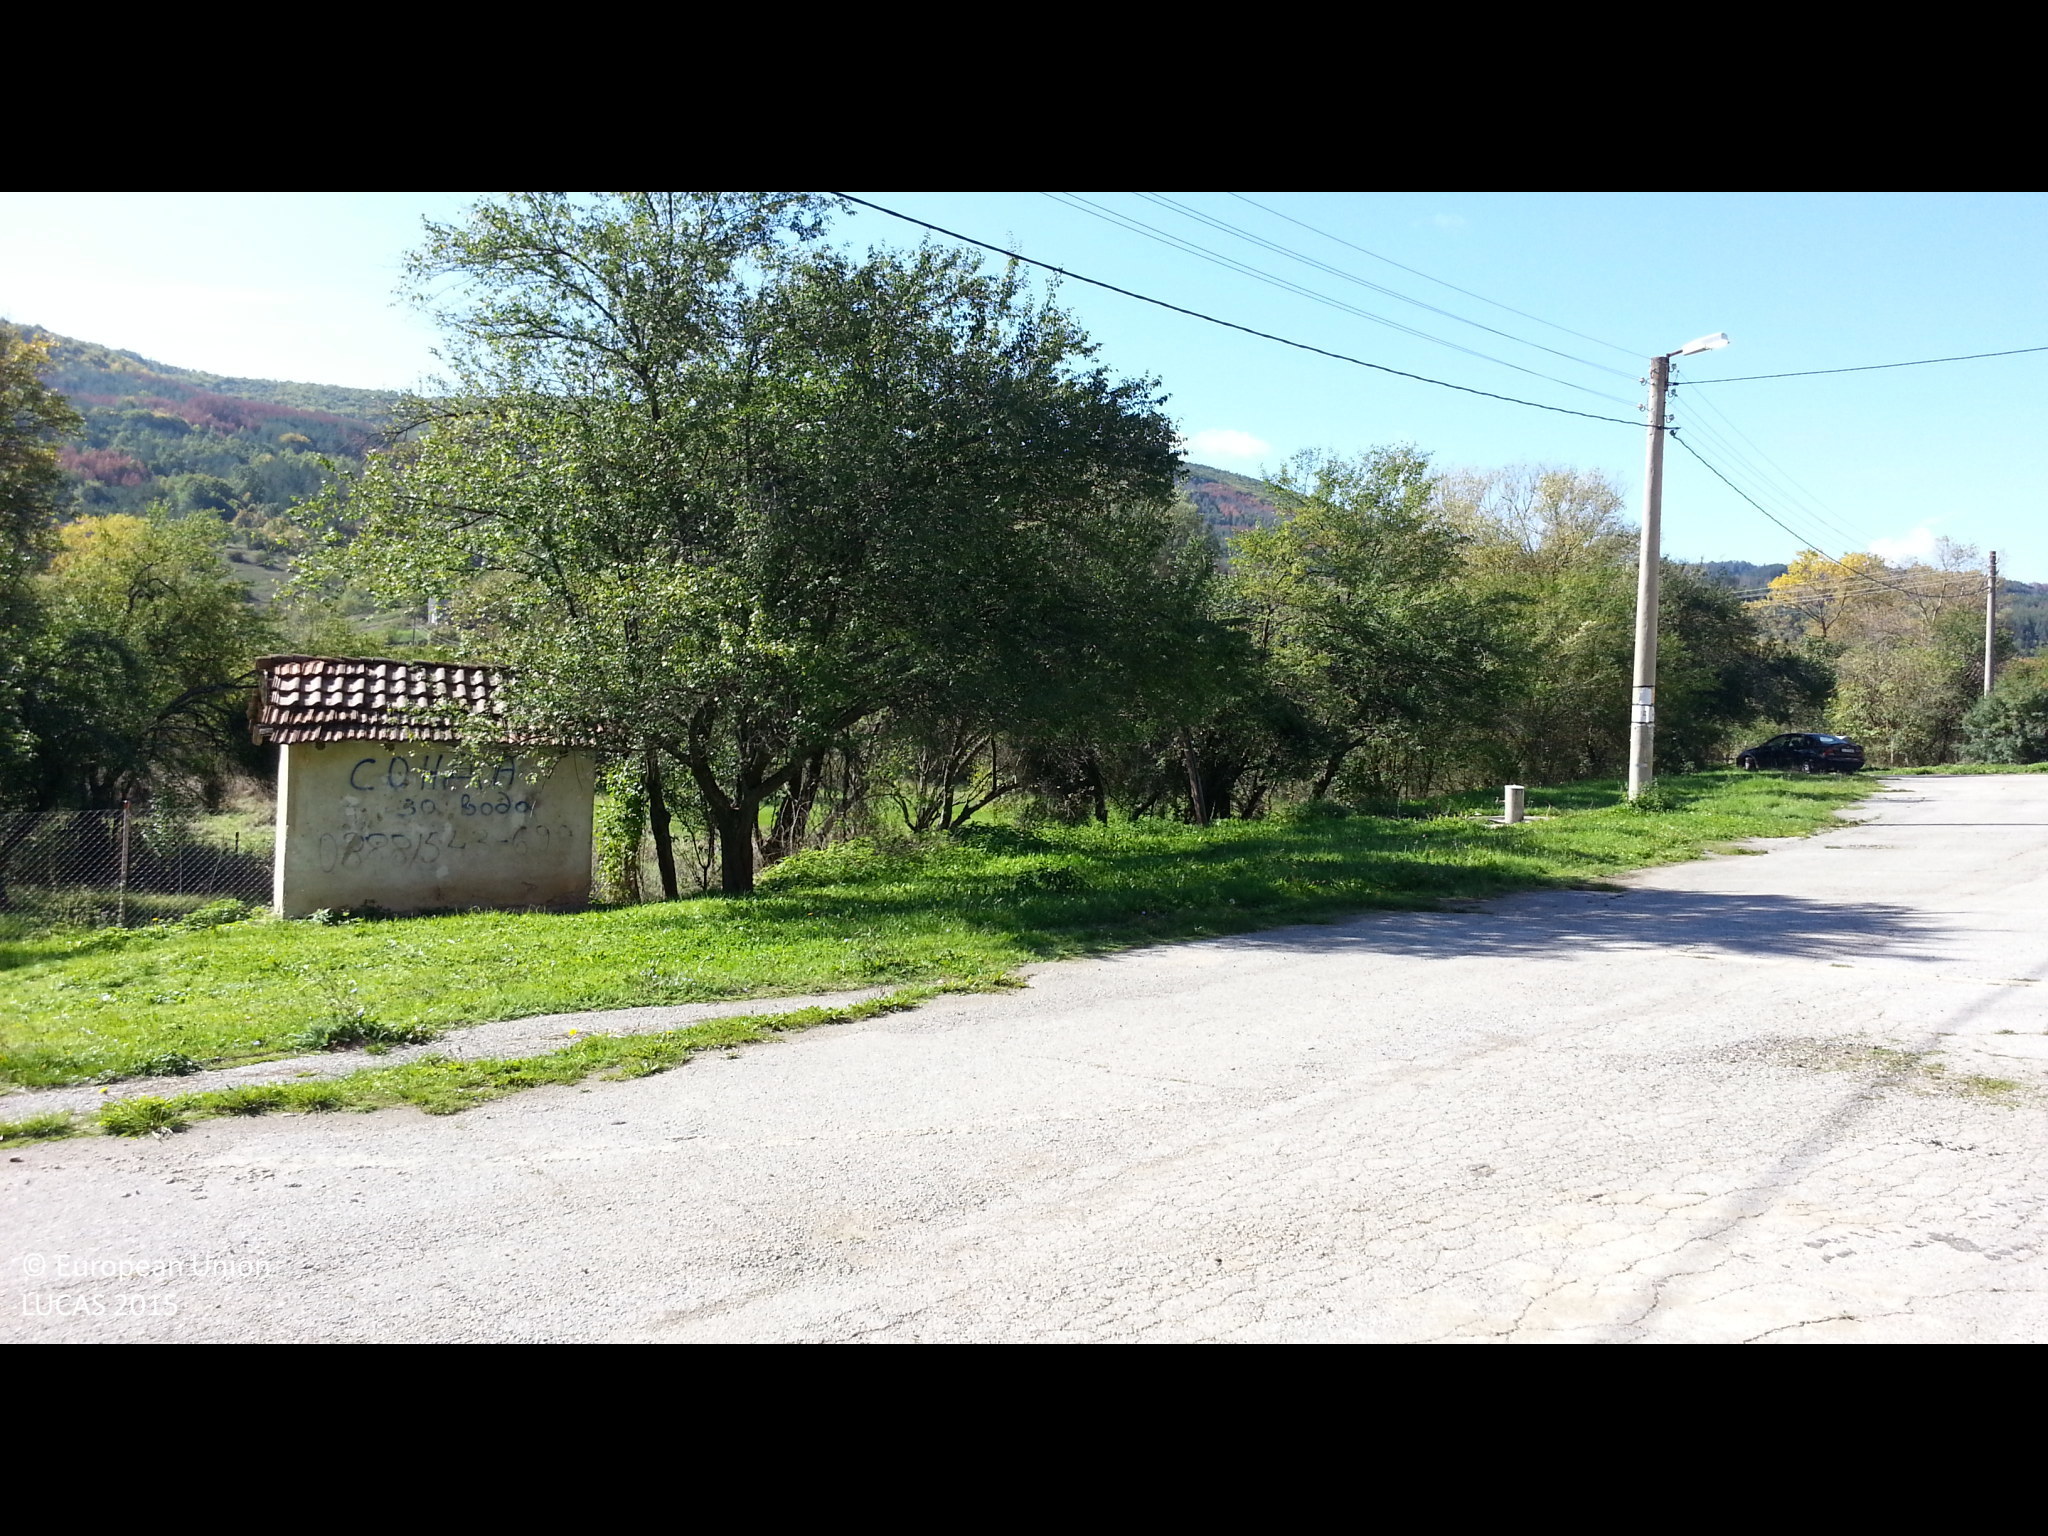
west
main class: Grassland
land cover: Grassland with sparse tree/shrub cover
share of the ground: > 75 %
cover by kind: herbaceous plants 90 %, broadleaved forest trees 5 %, shrubs 5 %
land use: Residential
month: October
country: BG
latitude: 42.6487
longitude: 22.5997
